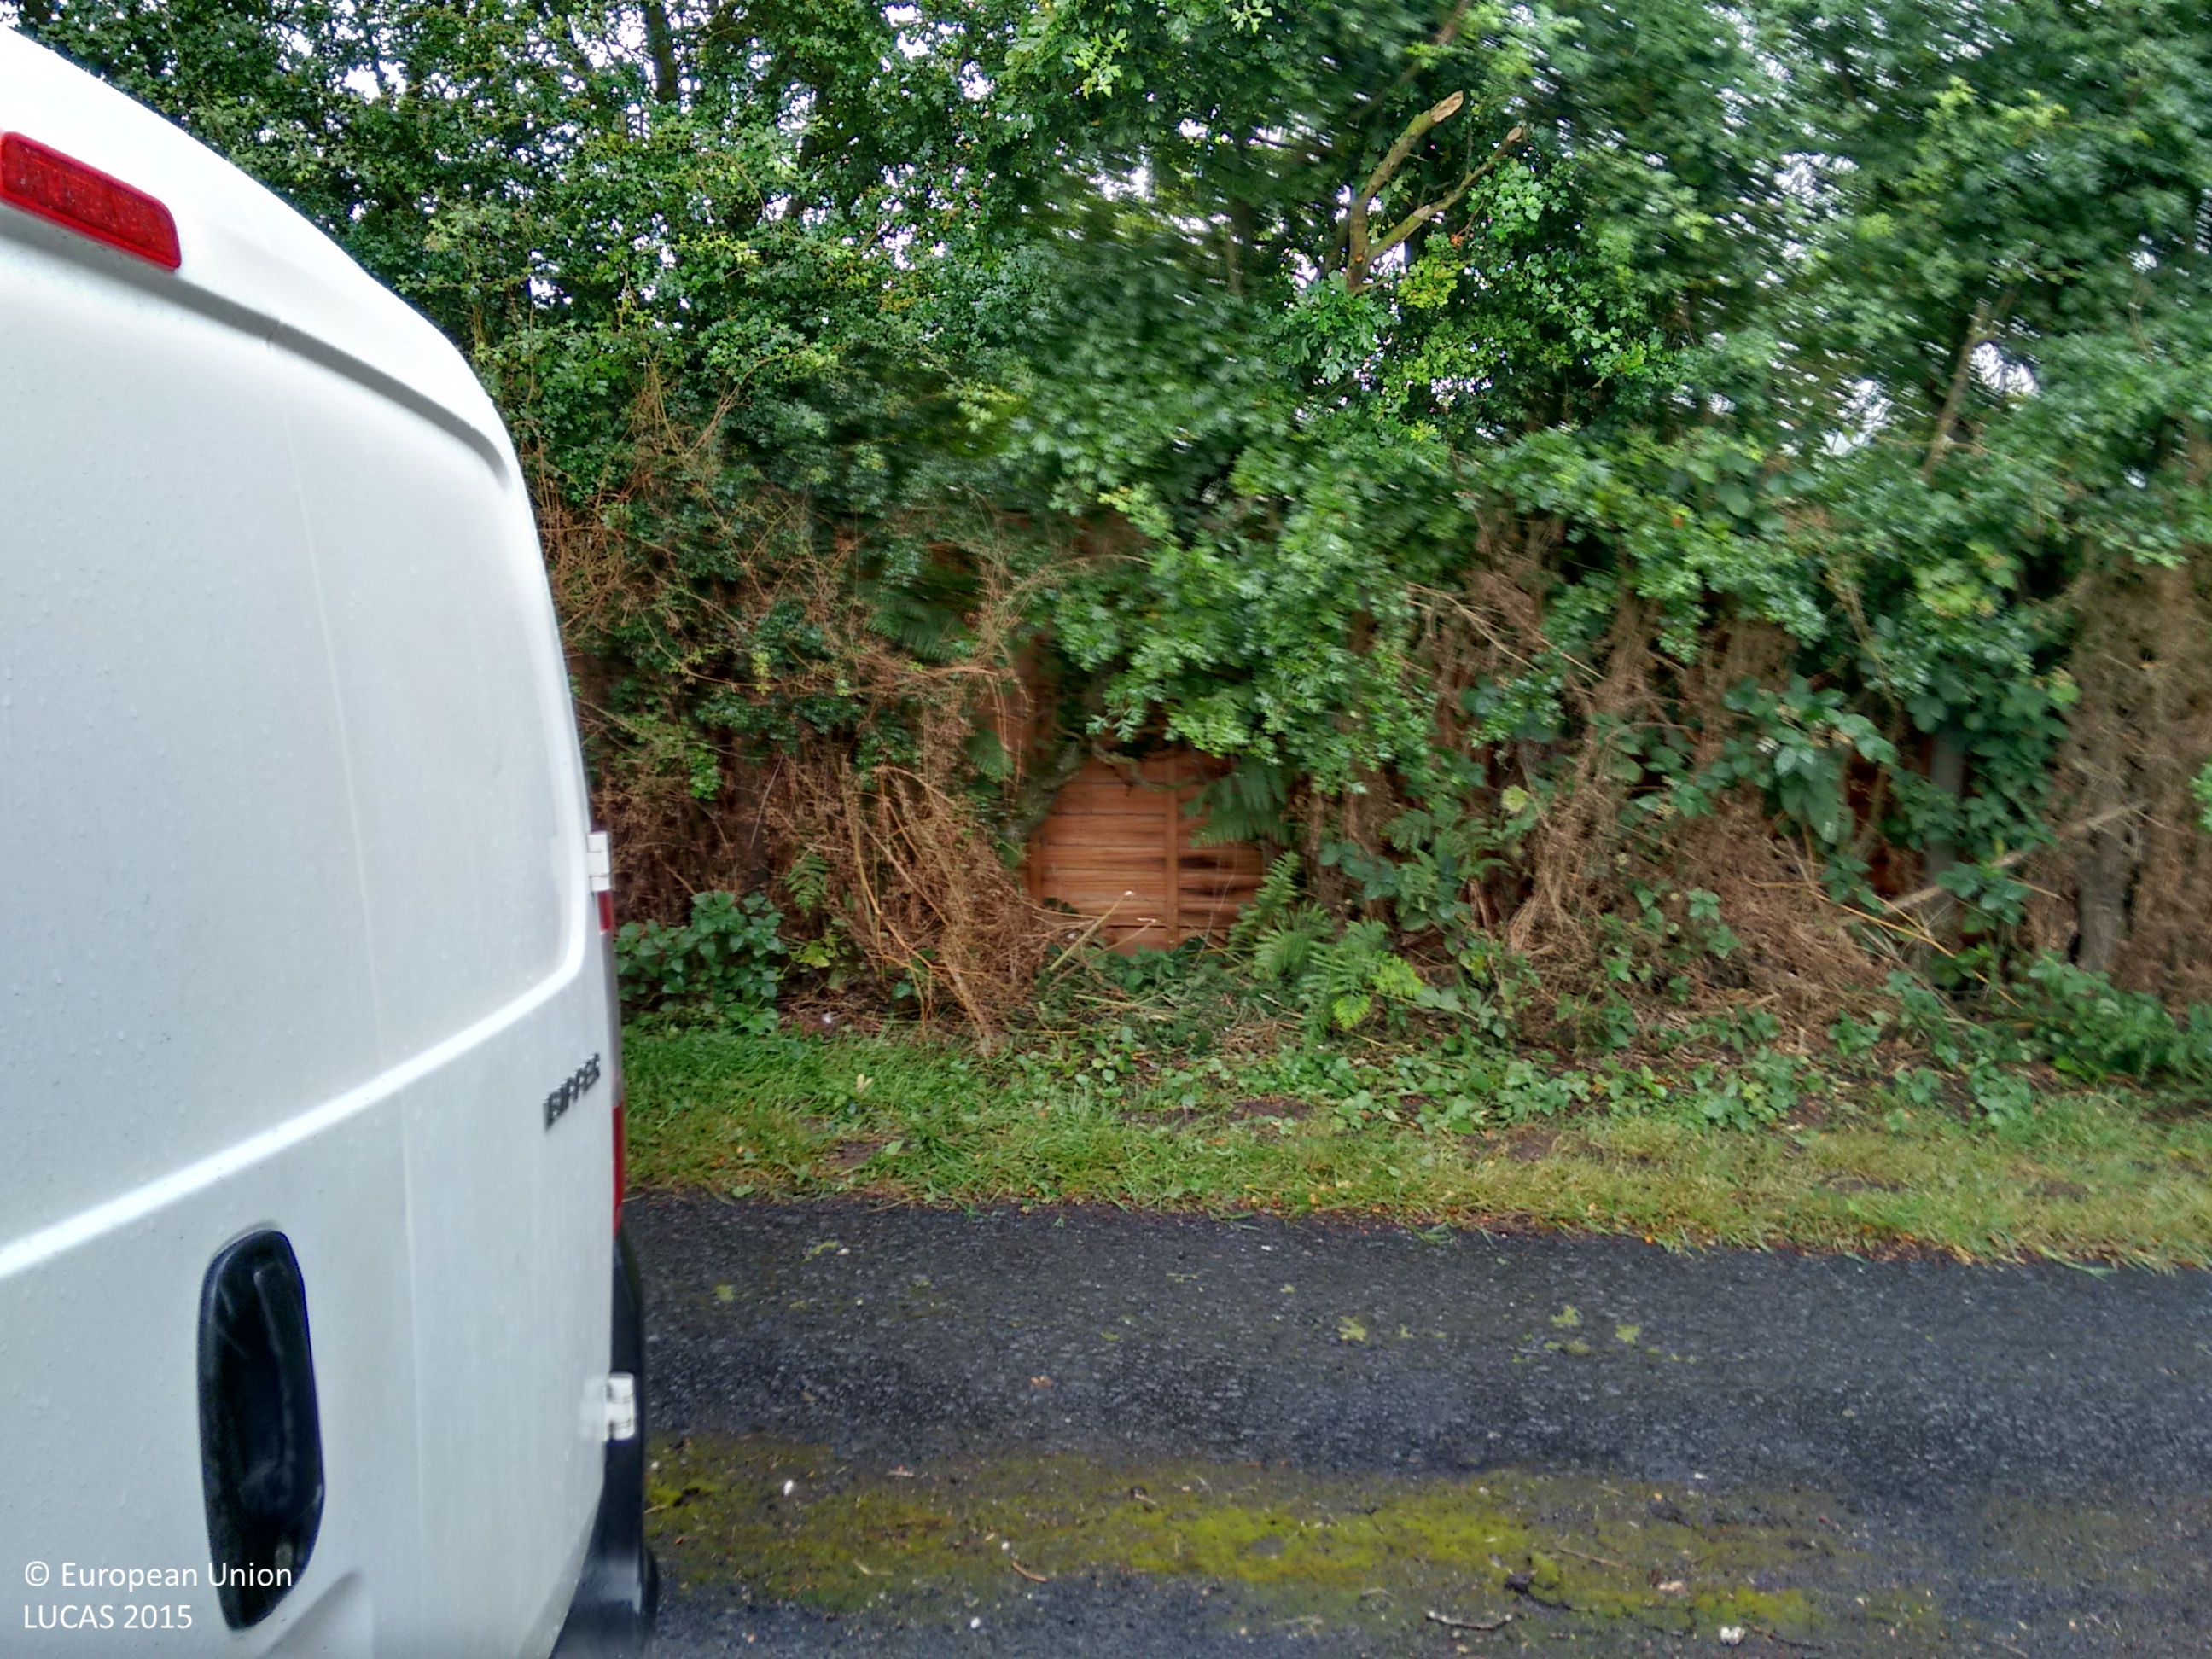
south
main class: Cropland
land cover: Barley
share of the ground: > 75 %
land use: Agriculture (excluding fallow land and kitchen gardens)
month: July
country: GB
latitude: 52.5223
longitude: -2.2507
